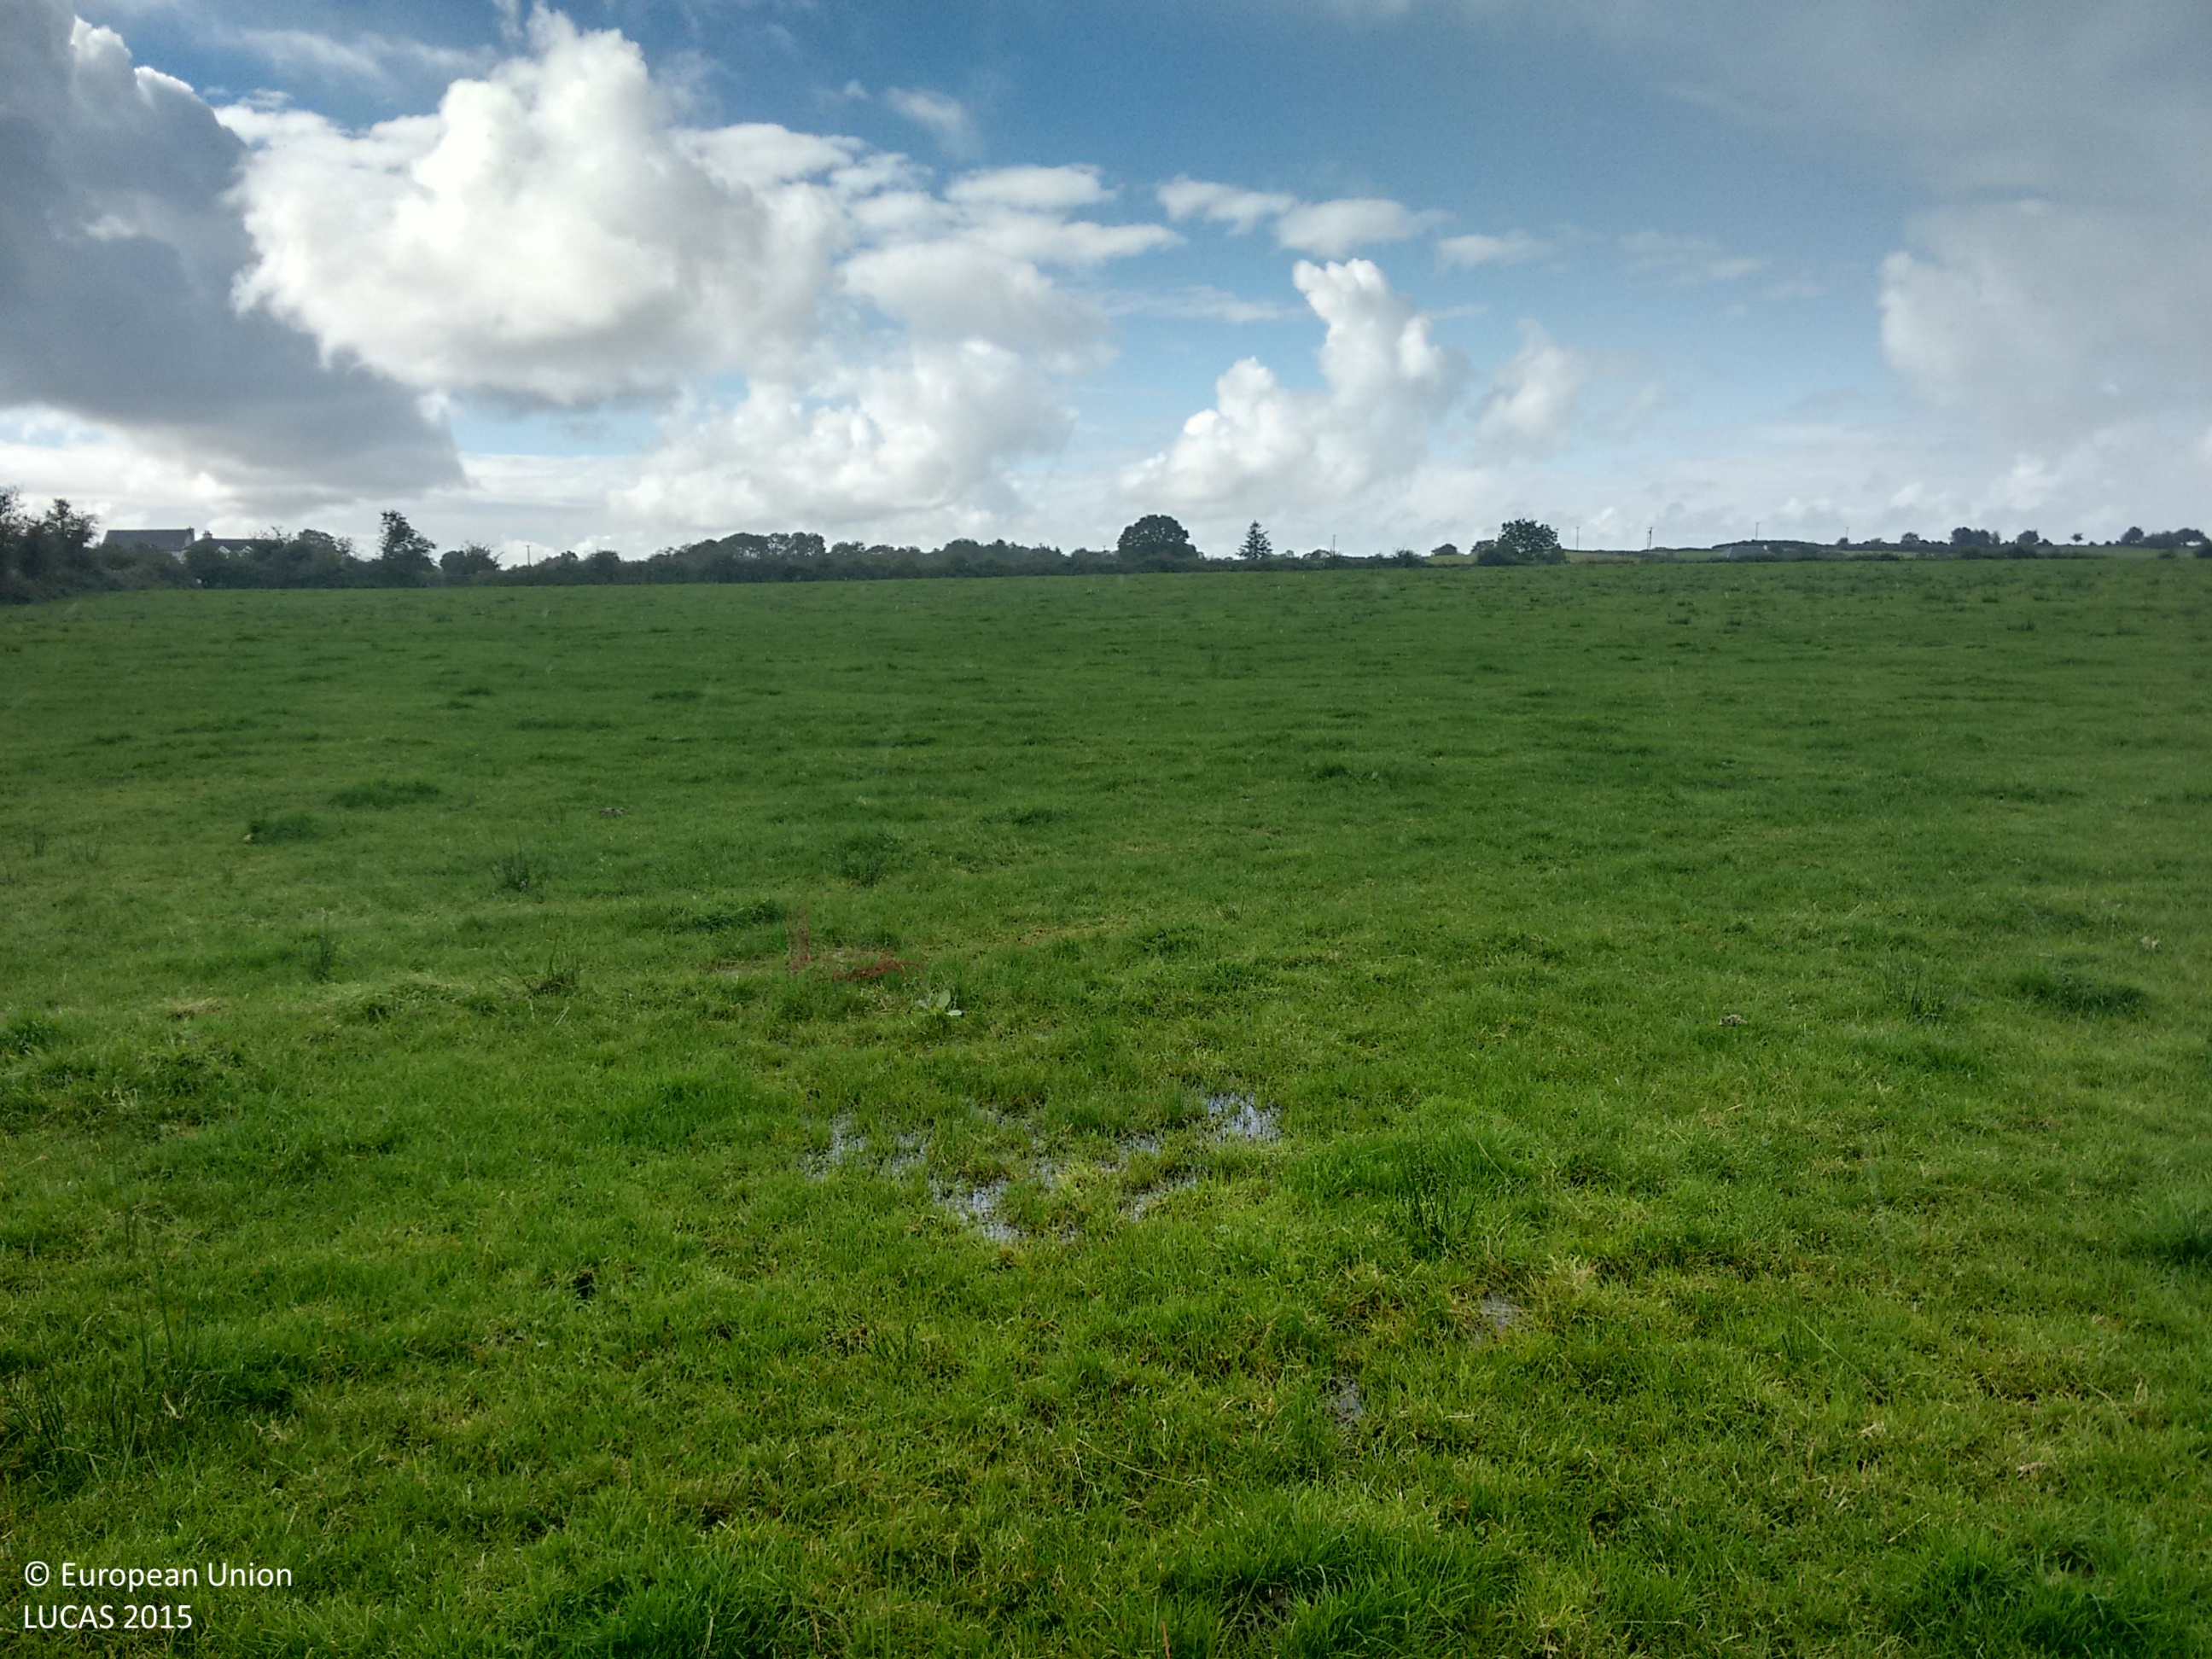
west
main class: Grassland
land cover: Grassland without tree/shrub cover
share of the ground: > 75 %
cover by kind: herbaceous plants 100 %
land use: Agriculture (excluding fallow land and kitchen gardens)
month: September
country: IE
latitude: 53.7698
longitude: -9.2001
